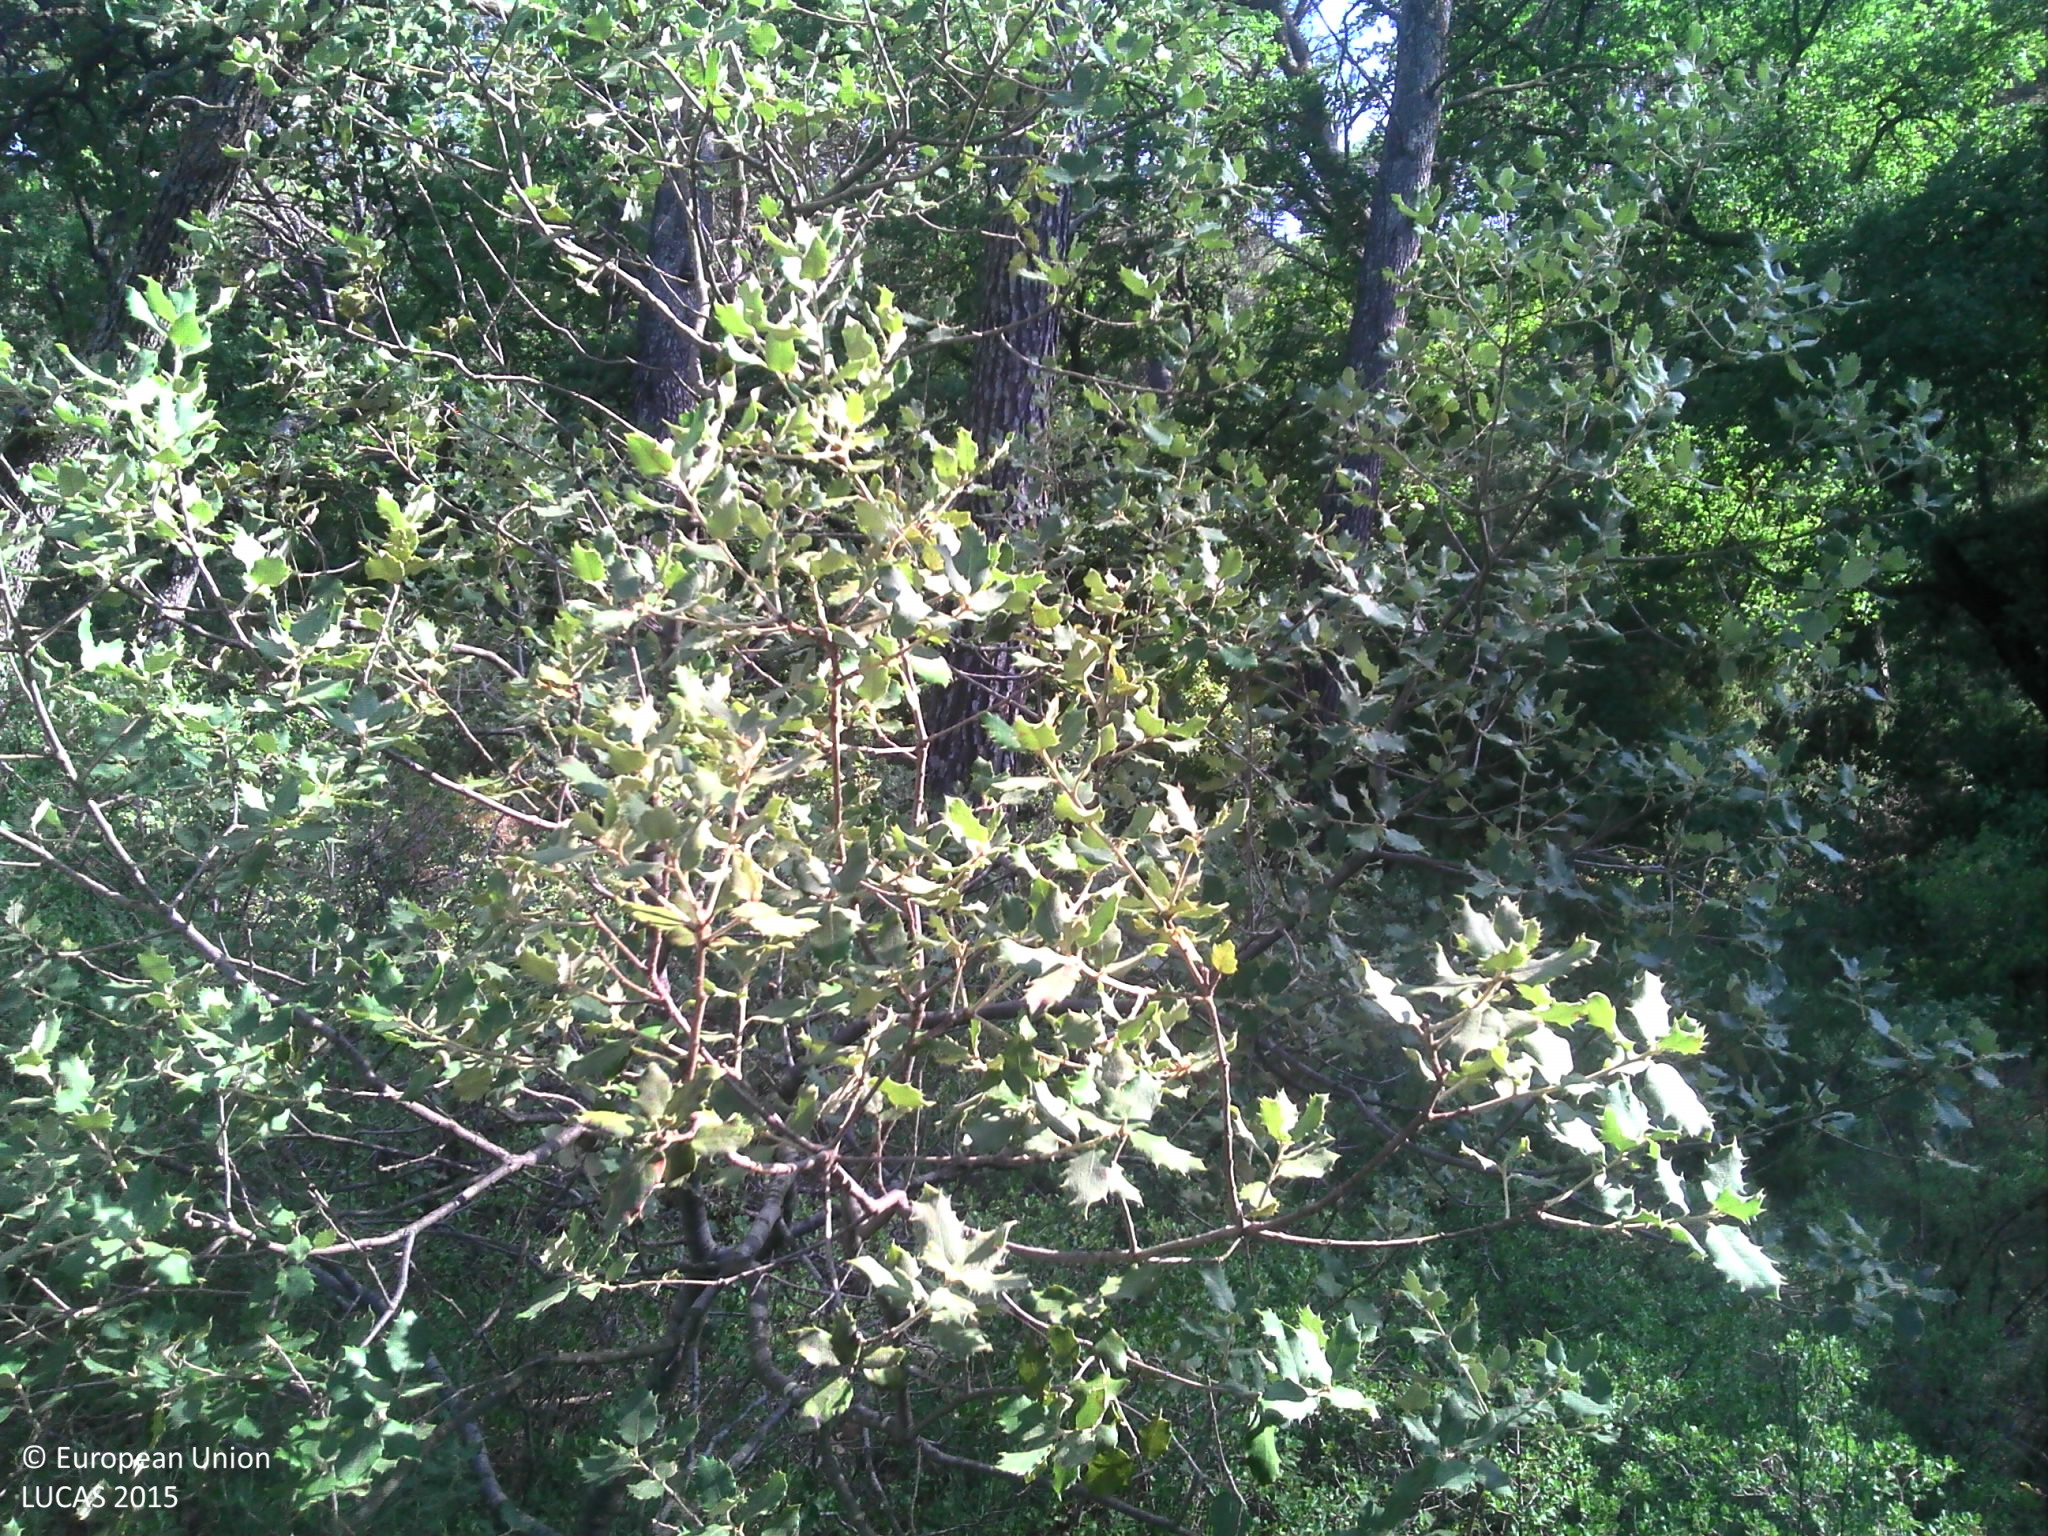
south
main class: Woodland
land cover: Pine dominated mixed woodland
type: coniferous forest of the mediterranean region
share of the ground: > 75 %
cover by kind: coniferous forest trees 40 %, broadleaved forest trees 35 %, shrubs 20 %, herbaceous plants 5 %
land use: Forestry
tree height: > 5 m
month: July
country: FR
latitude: 43.6855
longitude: 5.3324
